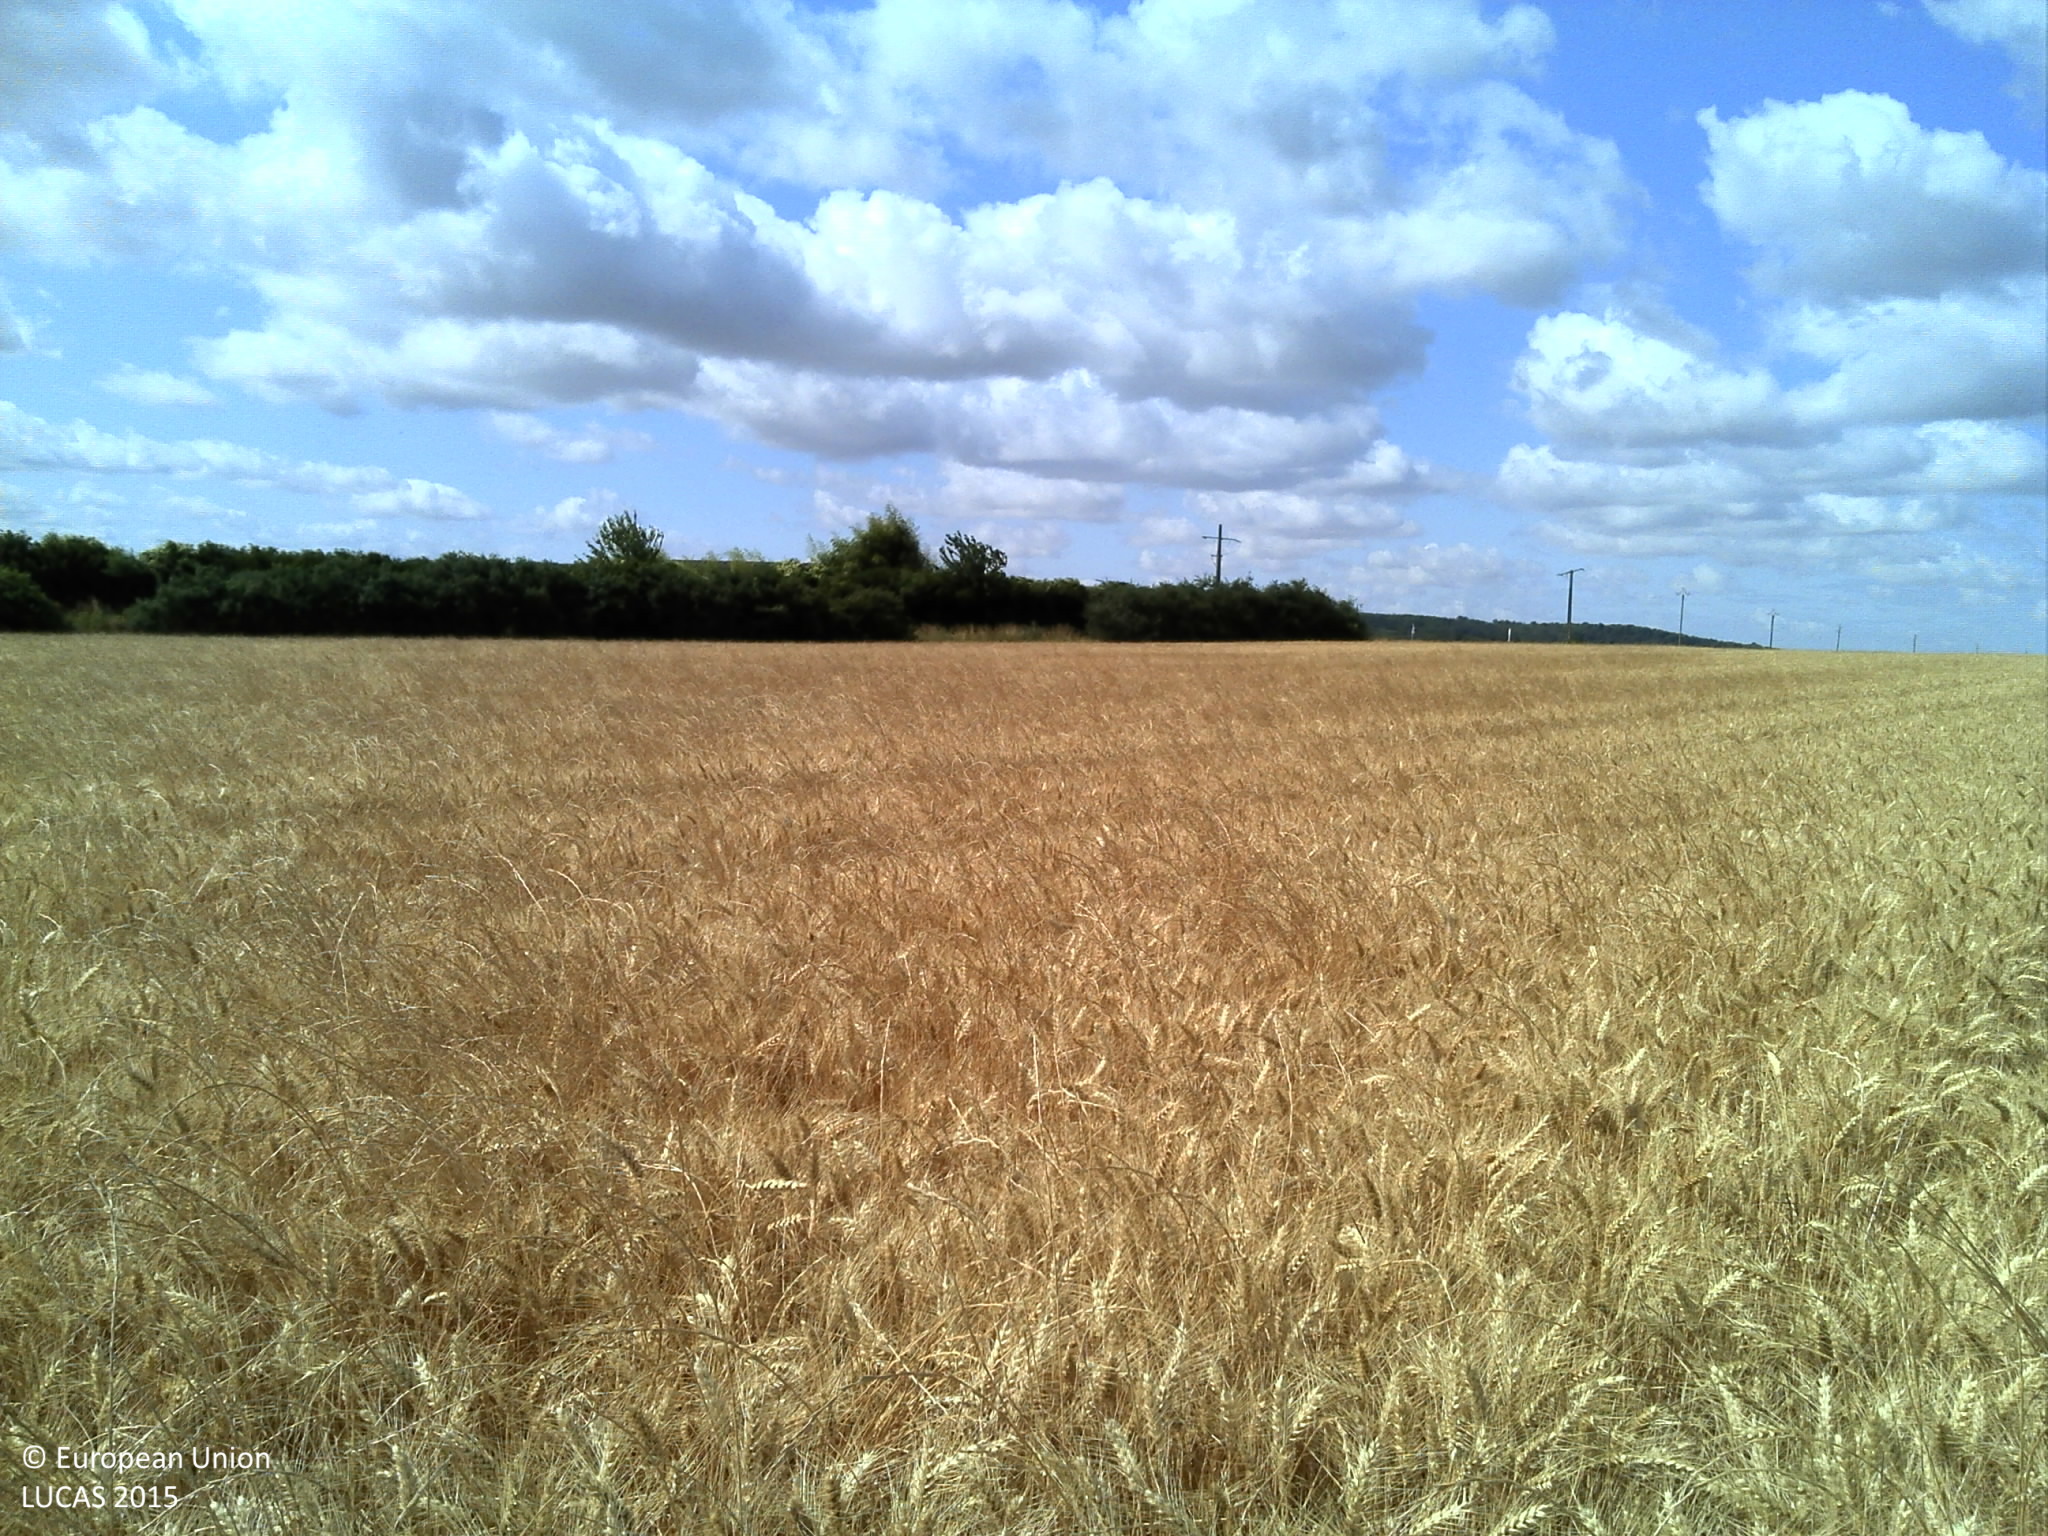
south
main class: Cropland
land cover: Durum wheat
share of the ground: > 75 %
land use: Agriculture (excluding fallow land and kitchen gardens)
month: July
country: FR
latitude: 48.5405
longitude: 2.4175
